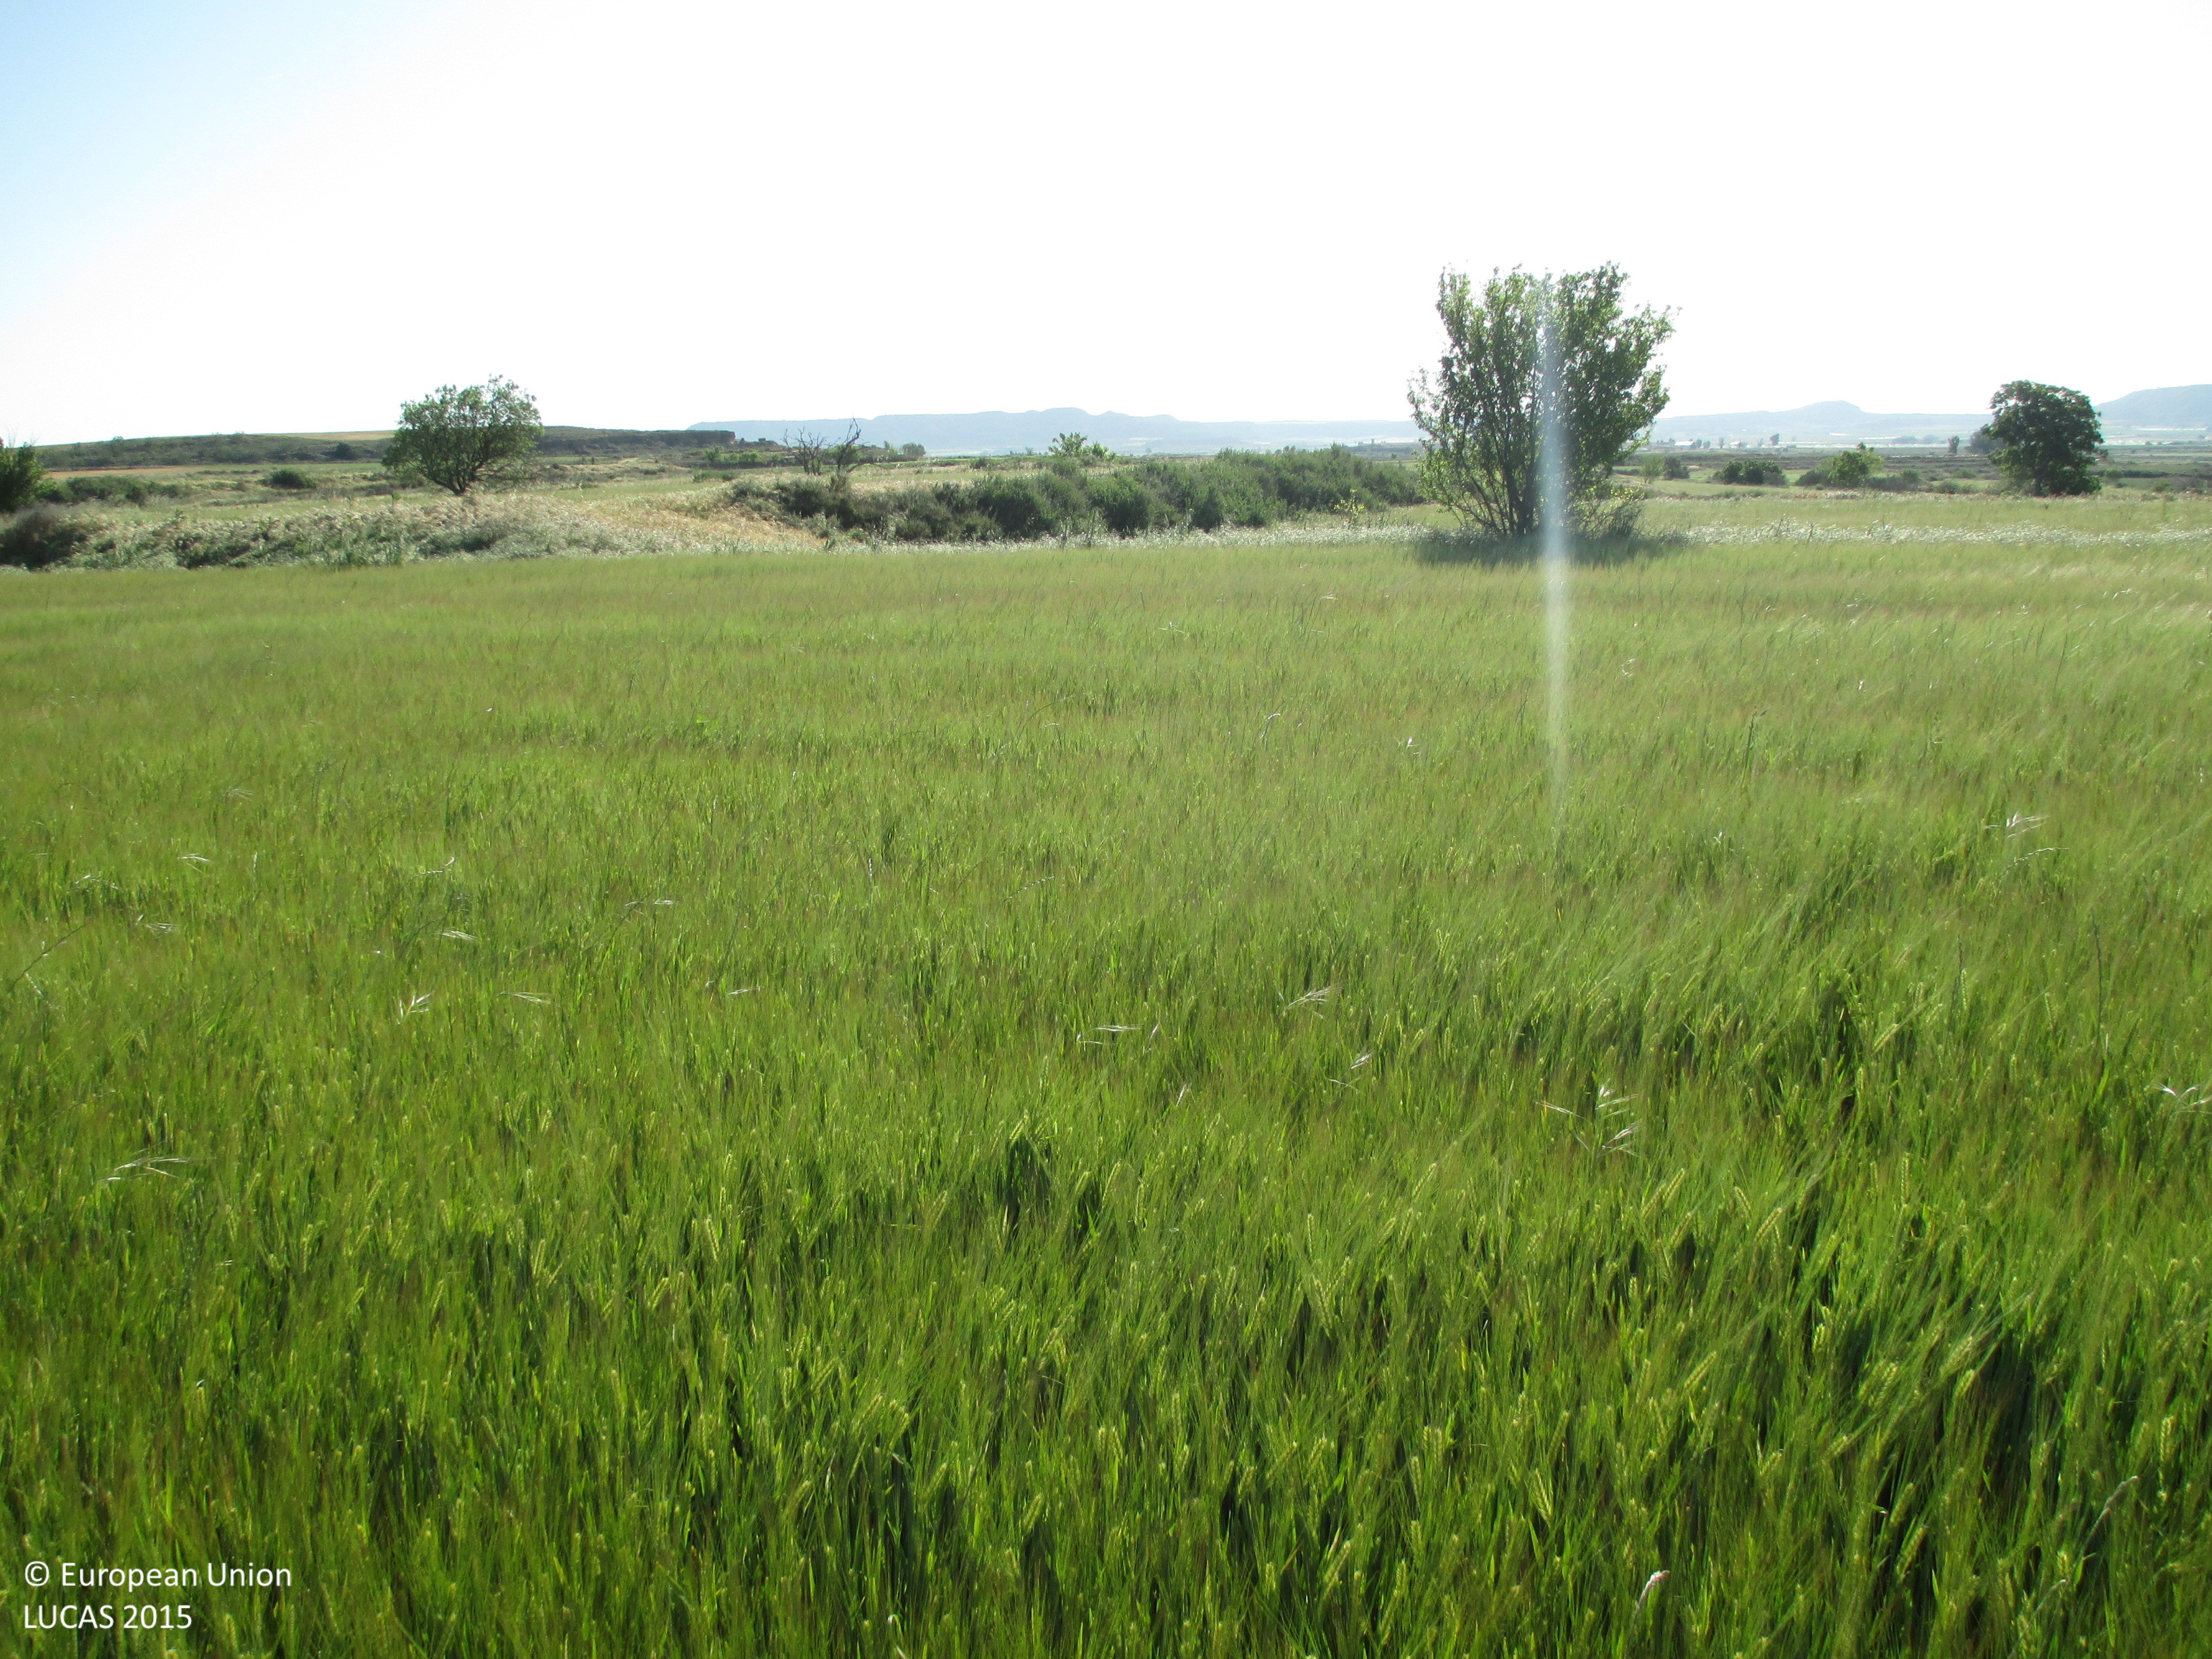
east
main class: Cropland
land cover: Barley
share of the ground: > 75 %
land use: Agriculture (excluding fallow land and kitchen gardens)
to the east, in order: Barley; Shruby margins; Single bushes/trees; Barley; Shrubland without tree cover; Ditches and canals; Shrubland without tree cover; Barley; Shrubland with sparse tree cover; Tracks; Shruby margins; Shrubland with sparse tree cover; Barley; Grass margins; Barley
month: May
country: ES
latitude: 41.9576
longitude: -0.3602
